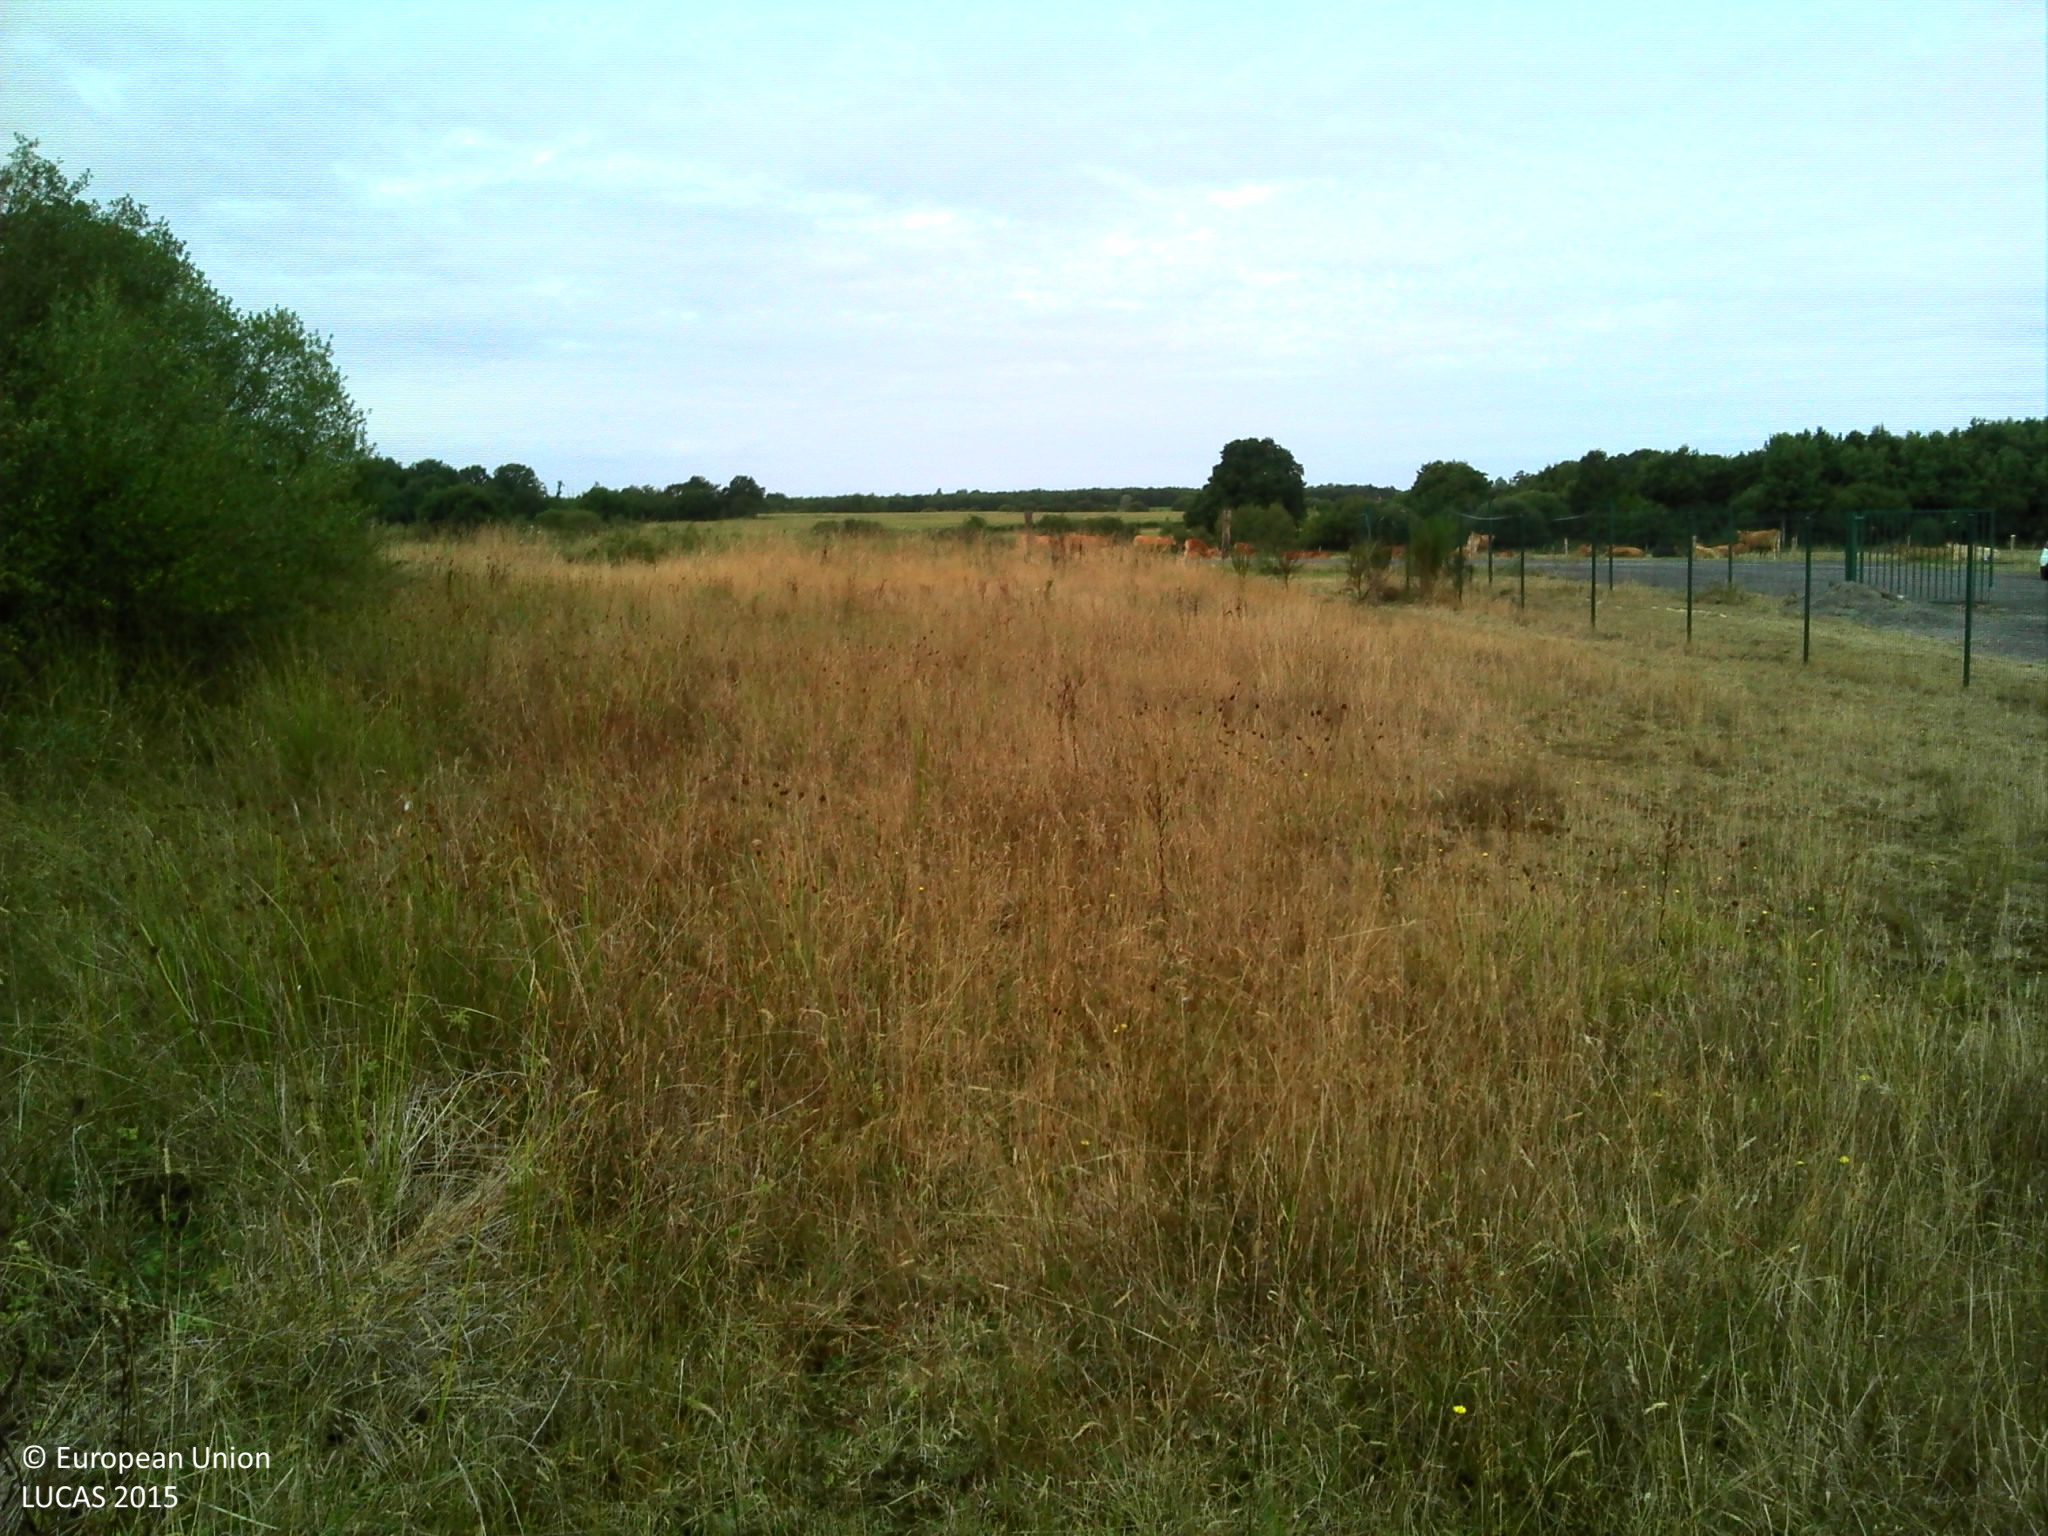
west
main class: Grassland
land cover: Grassland without tree/shrub cover
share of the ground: > 75 %
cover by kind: herbaceous plants 95 %, shrubs 5 %
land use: Semi-natural and natural areas not in use
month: August
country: FR
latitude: 47.0486
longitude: -1.3991
